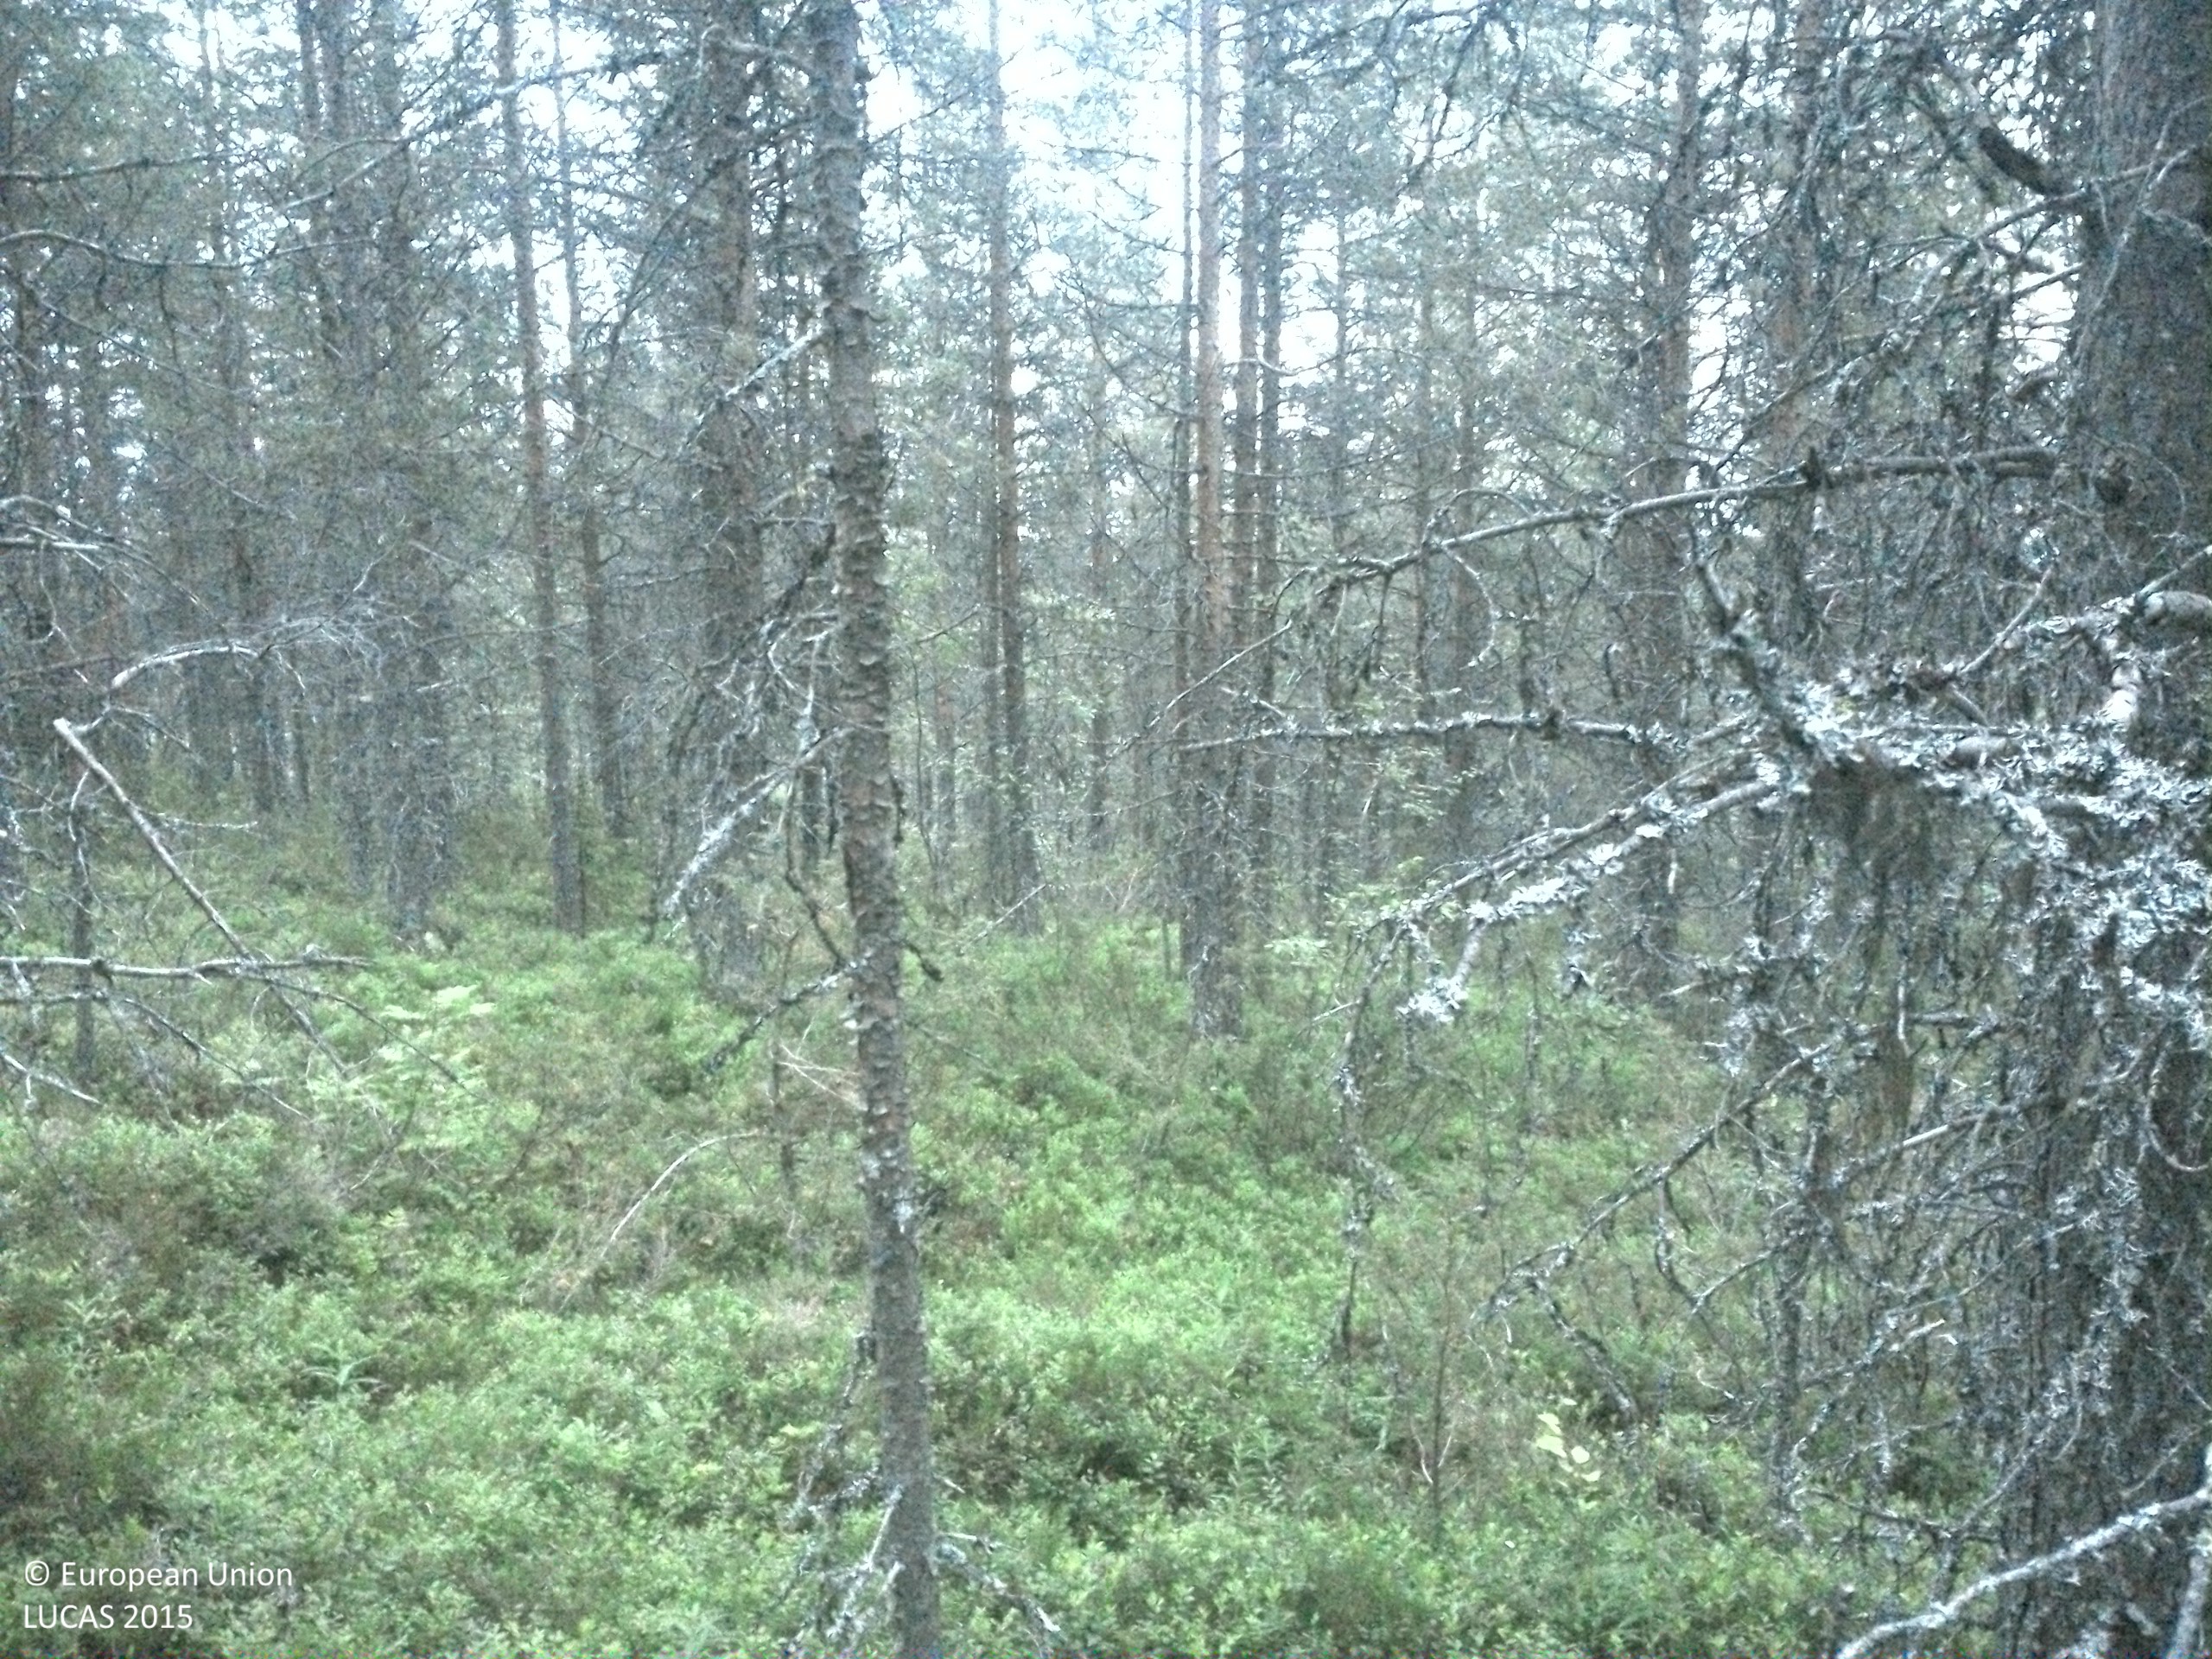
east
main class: Woodland
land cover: Pine dominated coniferous woodland
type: boreal forest
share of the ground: 50 - 75 %
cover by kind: coniferous forest trees 55 %, shrubs 35 %, broadleaved forest trees 5 %, herbaceous plants 5 %
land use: Forestry
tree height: > 5 m
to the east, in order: Pine dominated coniferous woodland; Spruce dominated coniferous woodland; Spruce dominated mixed woodland
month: July
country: SE
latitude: 64.2252
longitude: 16.5858
